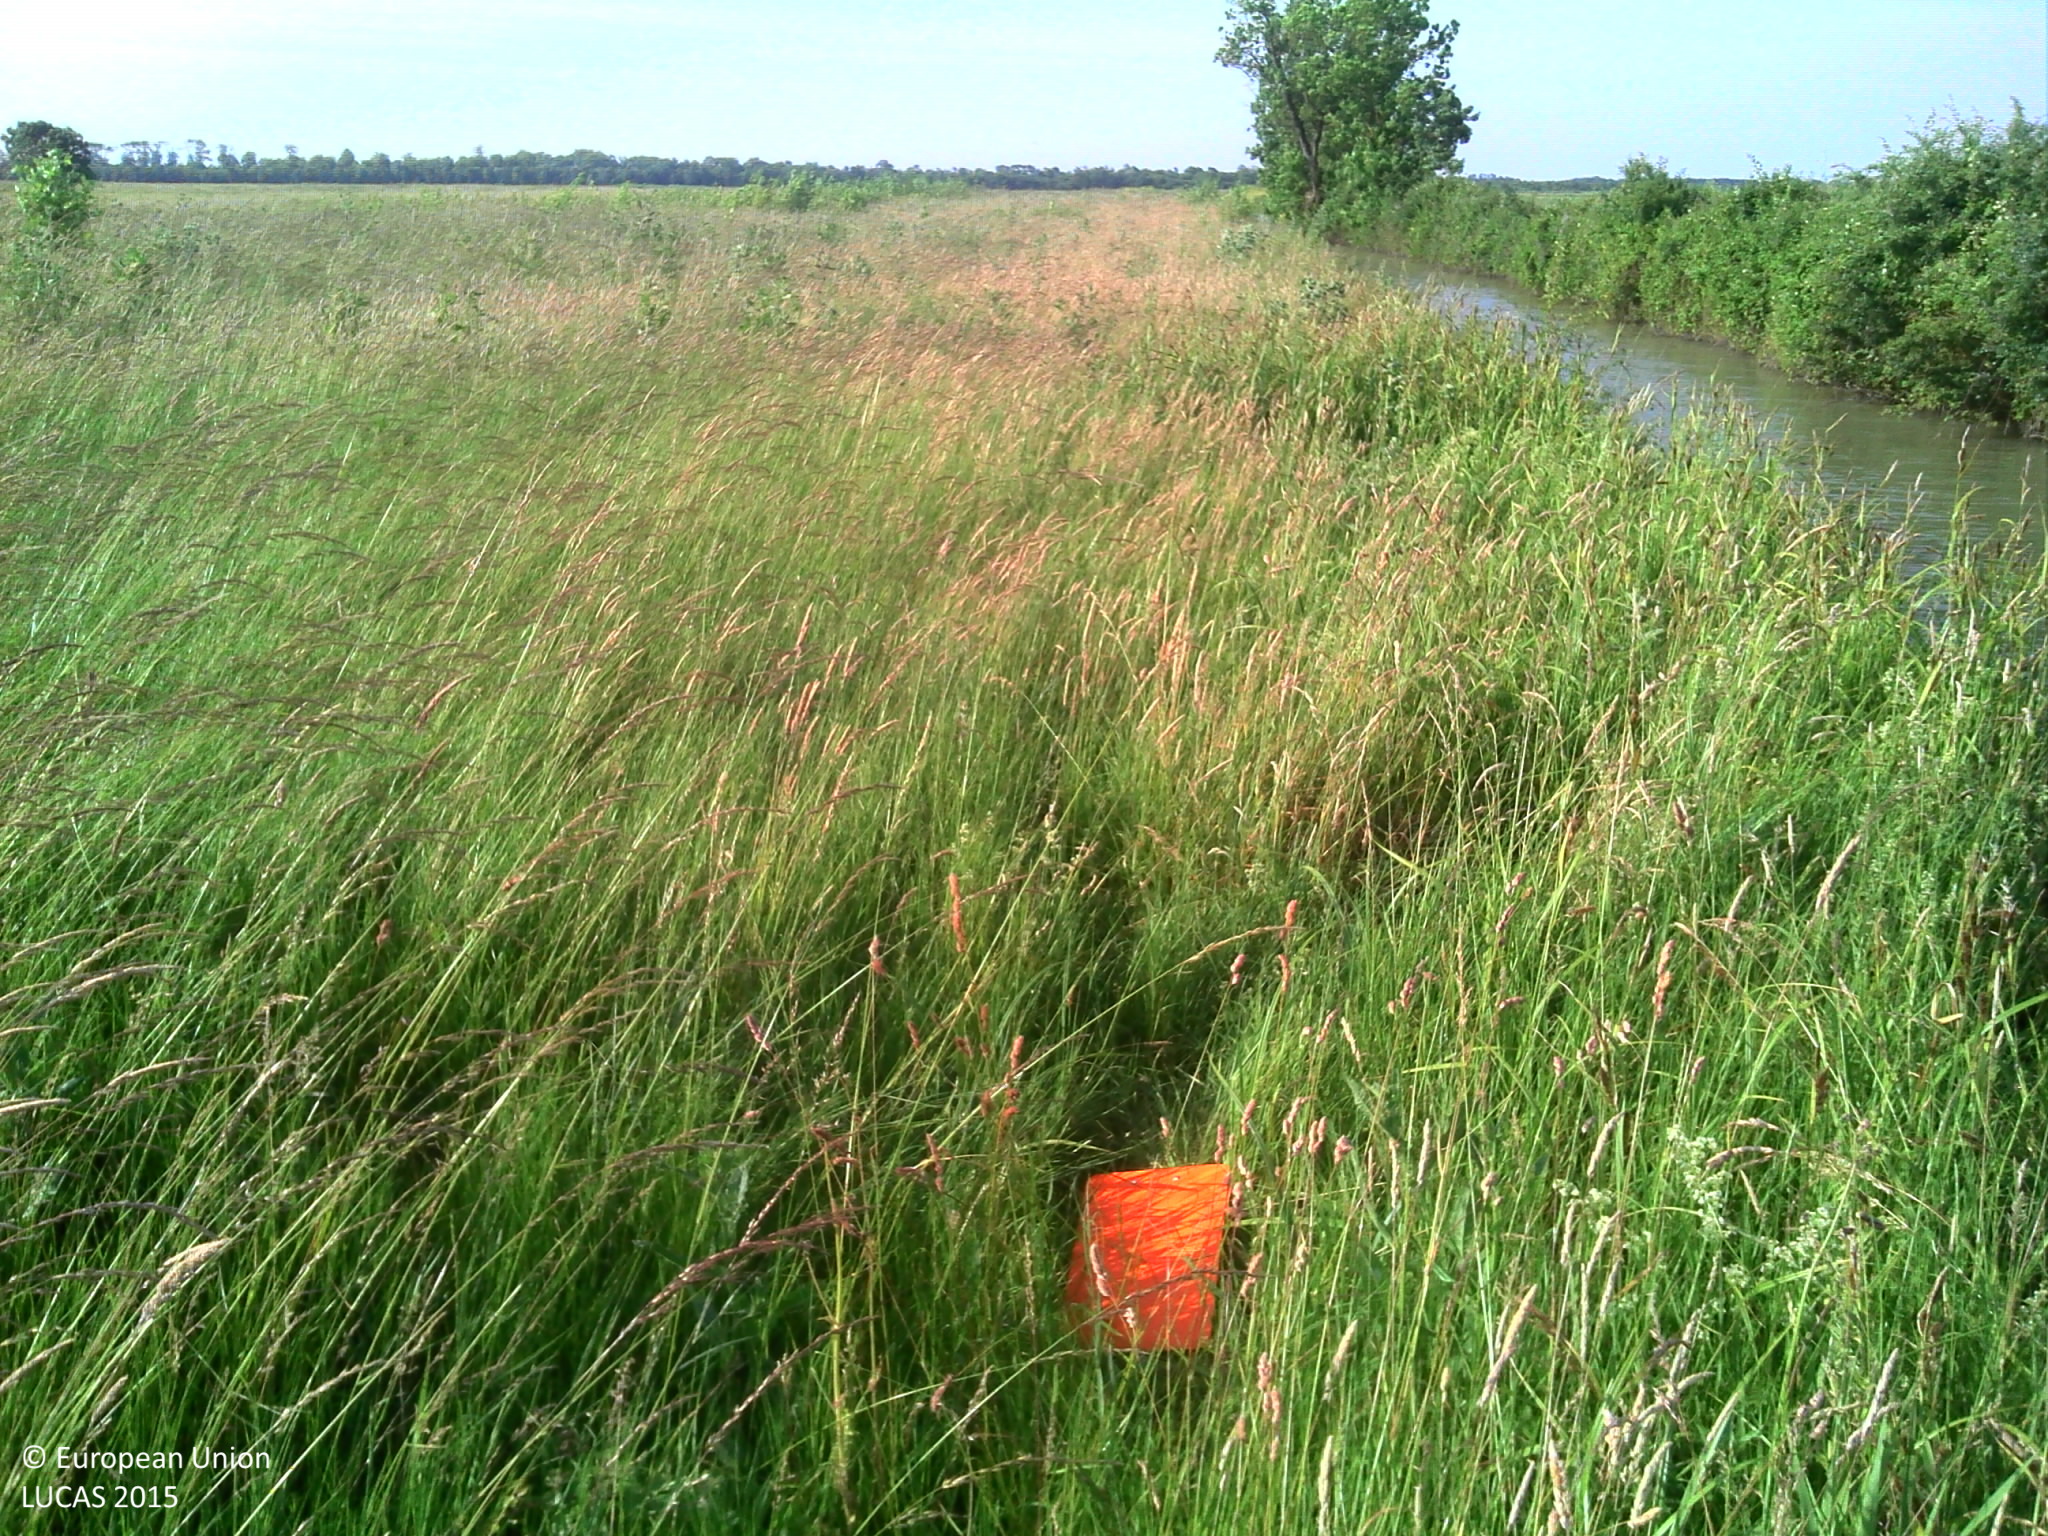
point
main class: Grassland
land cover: Grassland without tree/shrub cover
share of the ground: > 75 %
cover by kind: herbaceous plants 95 %, shrubs 5 %
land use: Agriculture (excluding fallow land and kitchen gardens)
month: June
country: FR
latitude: 46.0365
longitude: -0.9994
